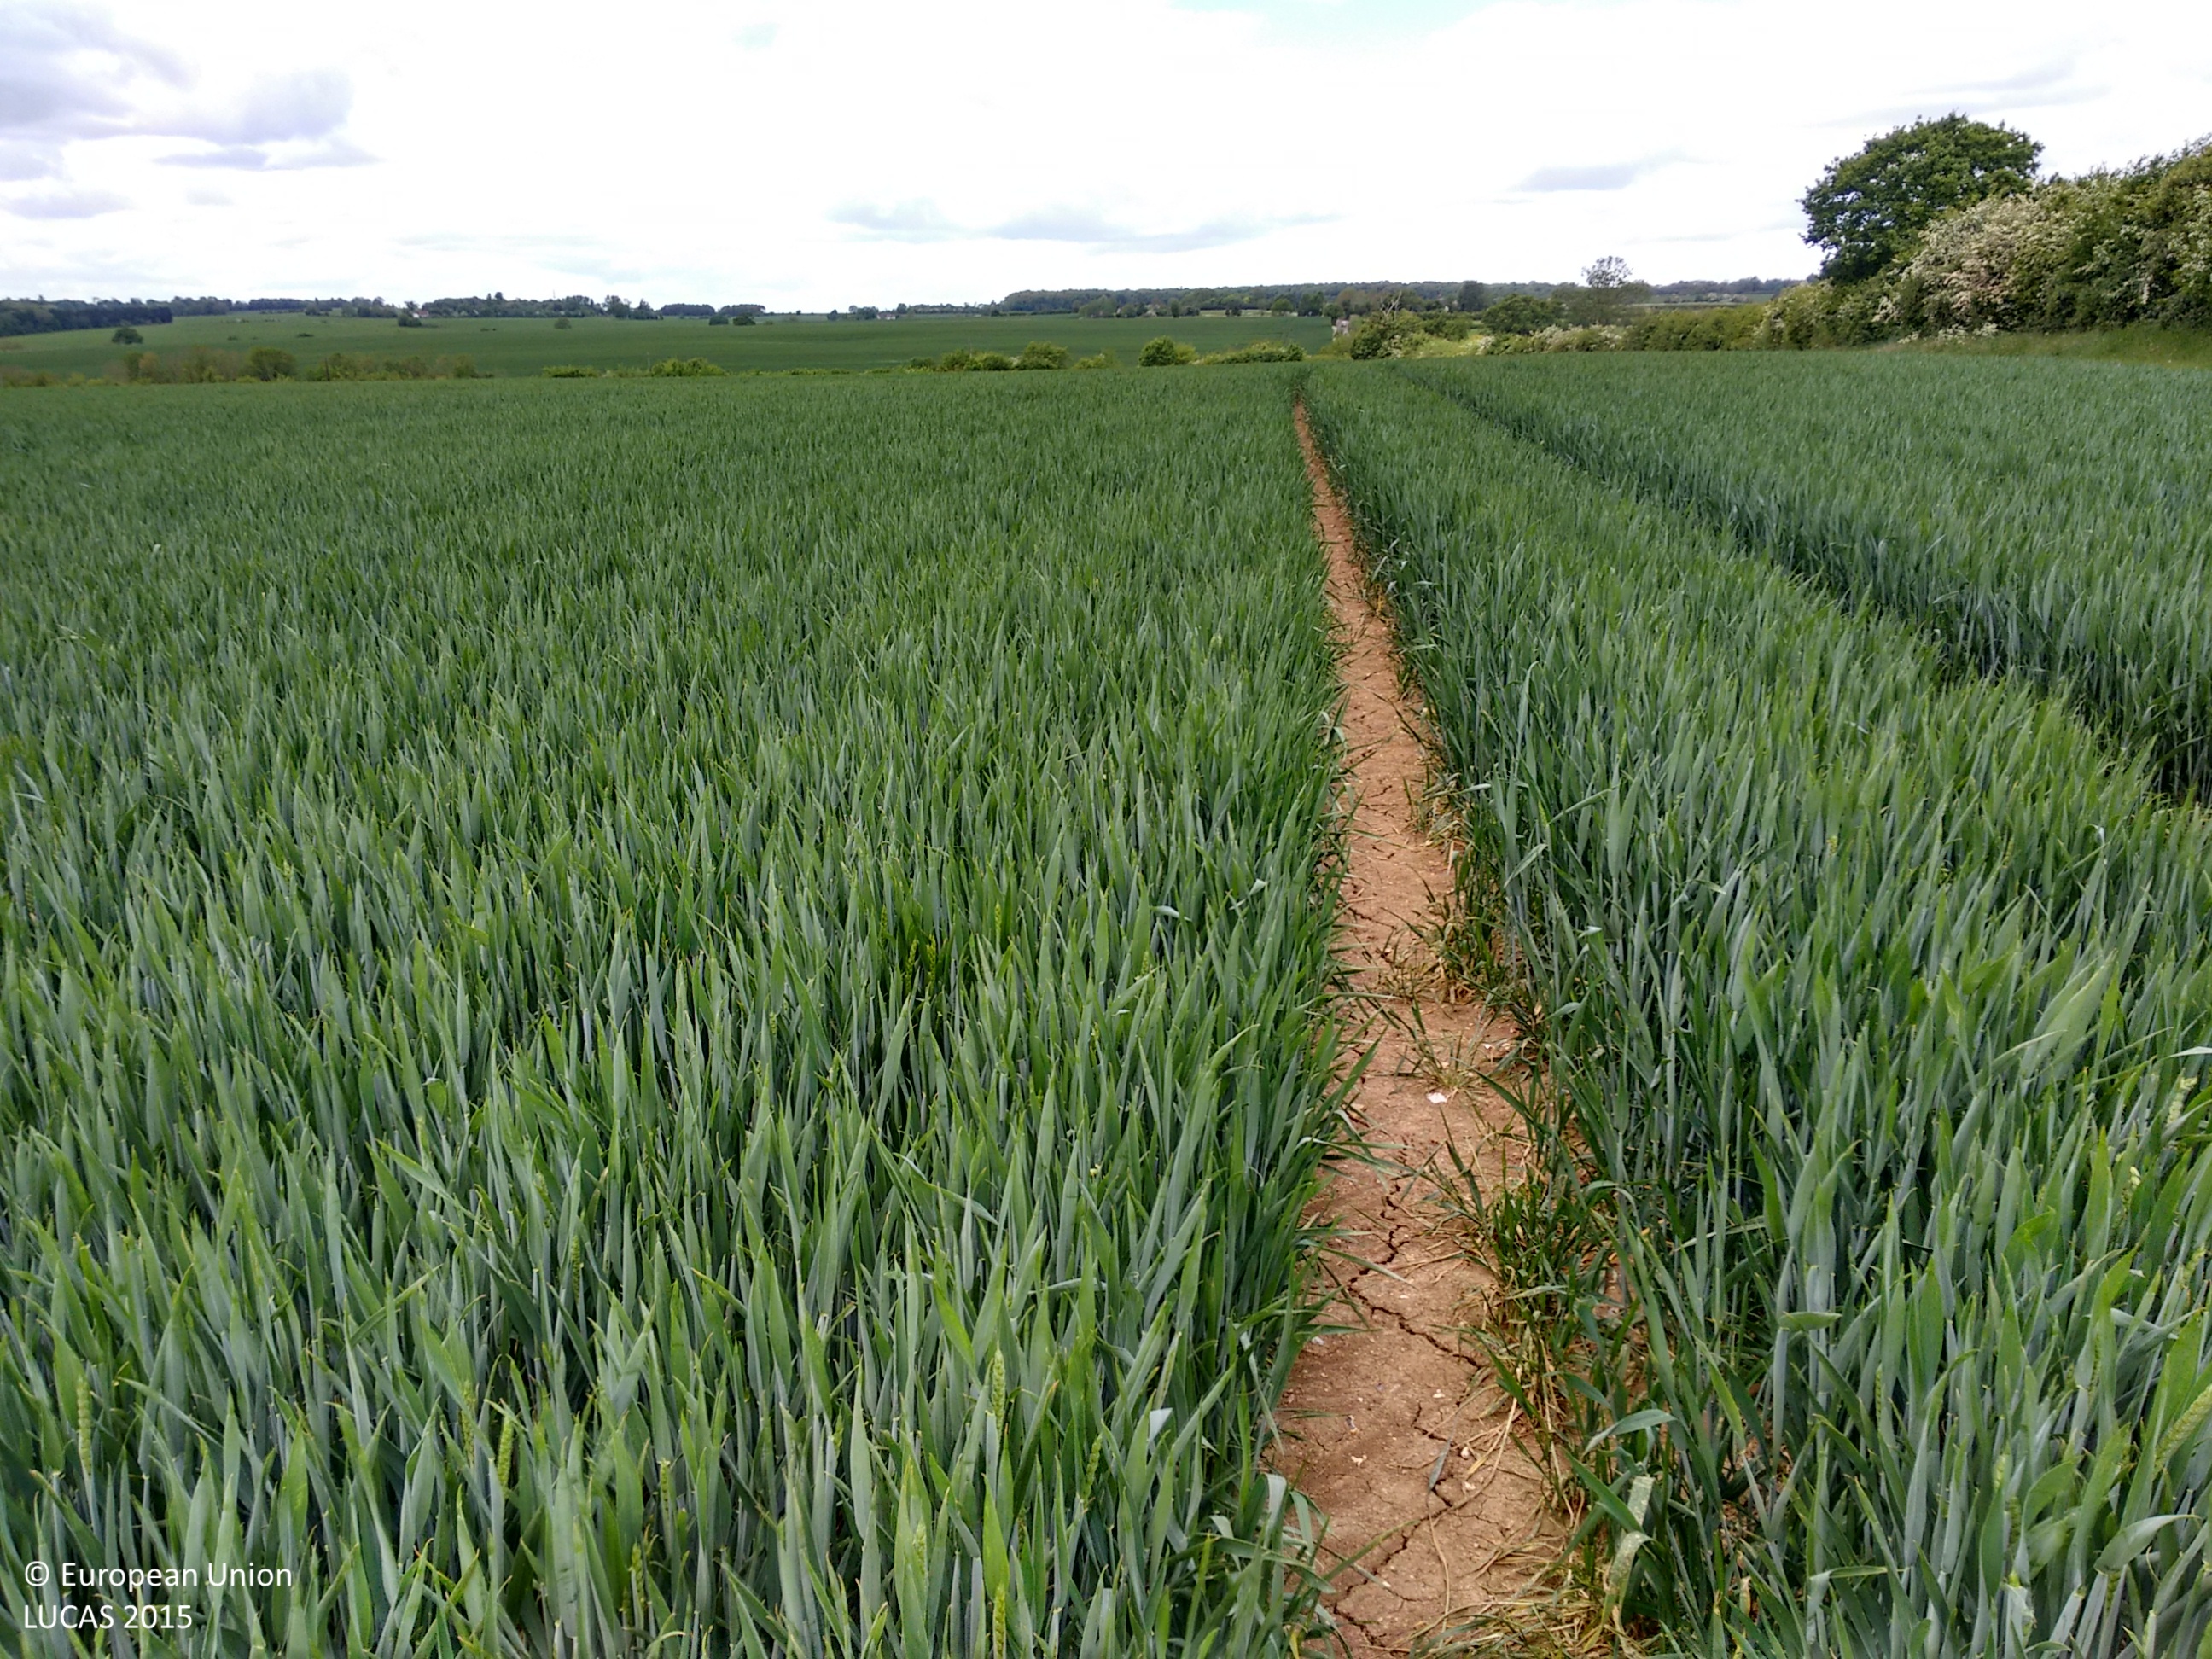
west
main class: Cropland
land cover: Common wheat
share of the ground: > 75 %
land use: Agriculture (excluding fallow land and kitchen gardens)
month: May
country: GB
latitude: 51.9260
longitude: 0.0943
